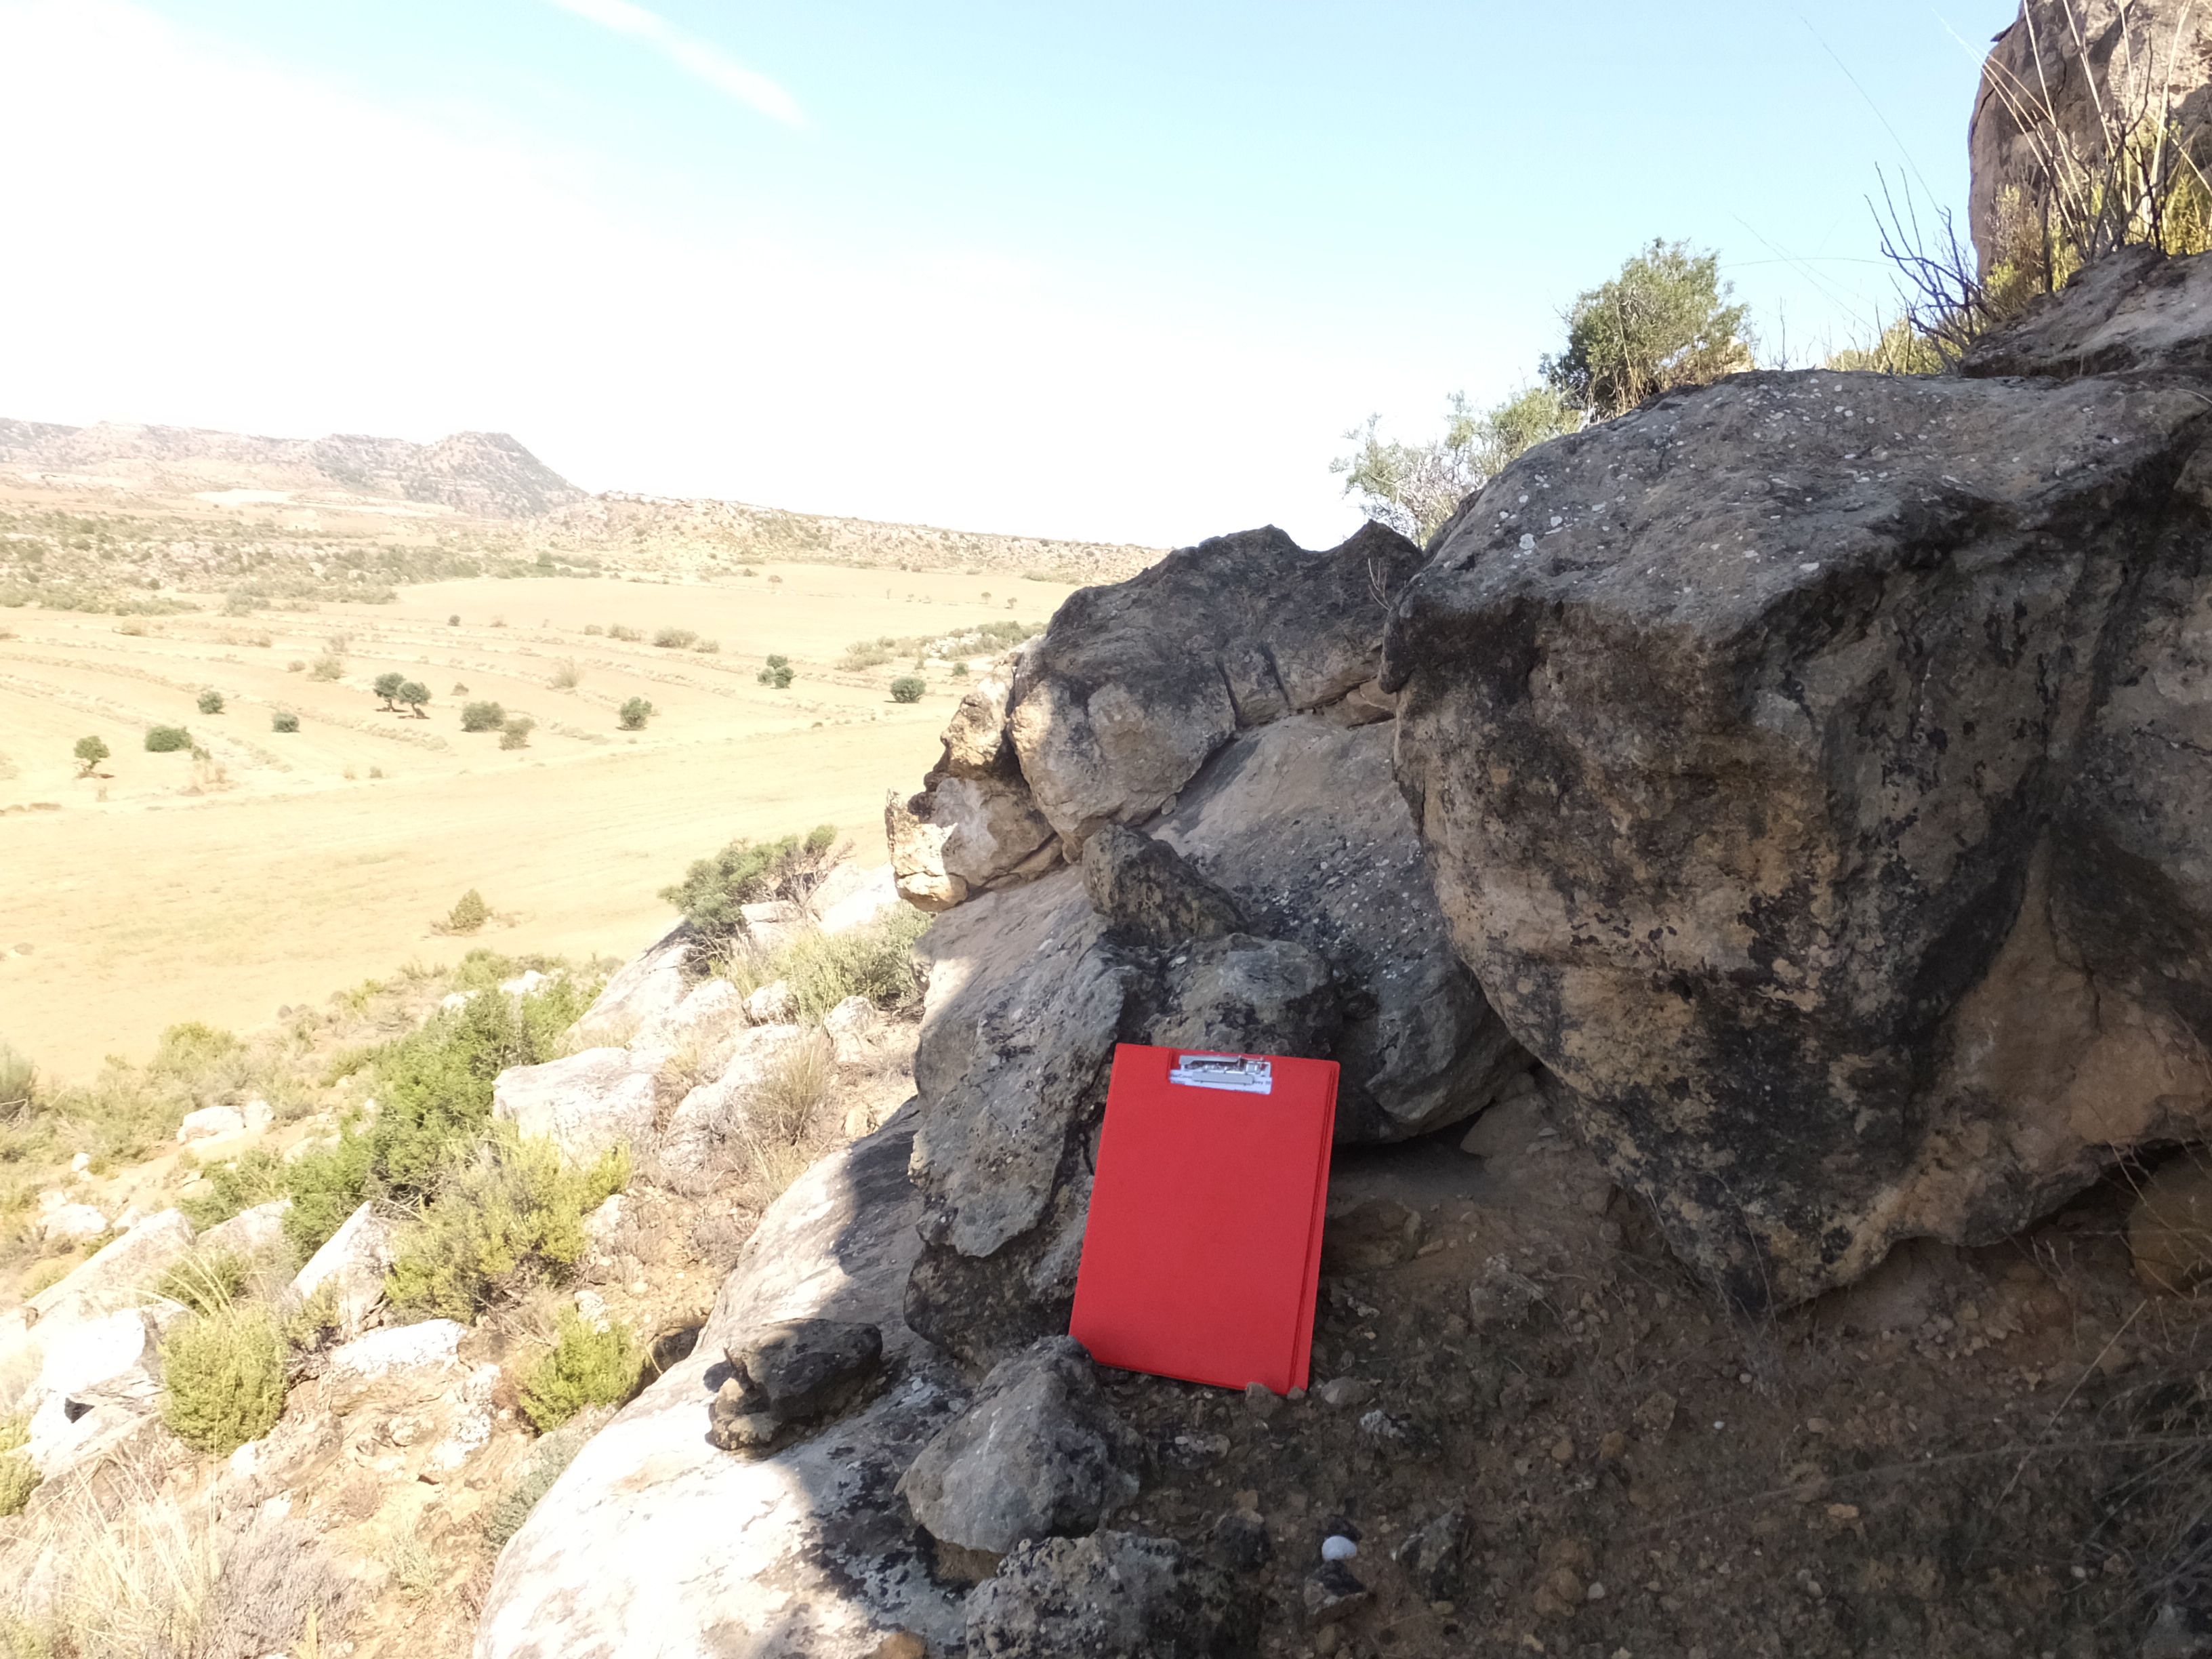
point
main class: Shrubland
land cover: Shrubland without tree cover
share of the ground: > 75 %
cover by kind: consolidated bare surface 50 %, shrubs 30 %, herbaceous plants 20 %
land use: Semi-natural and natural areas not in use
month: July
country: ES
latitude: 41.1540
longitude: -0.0333
